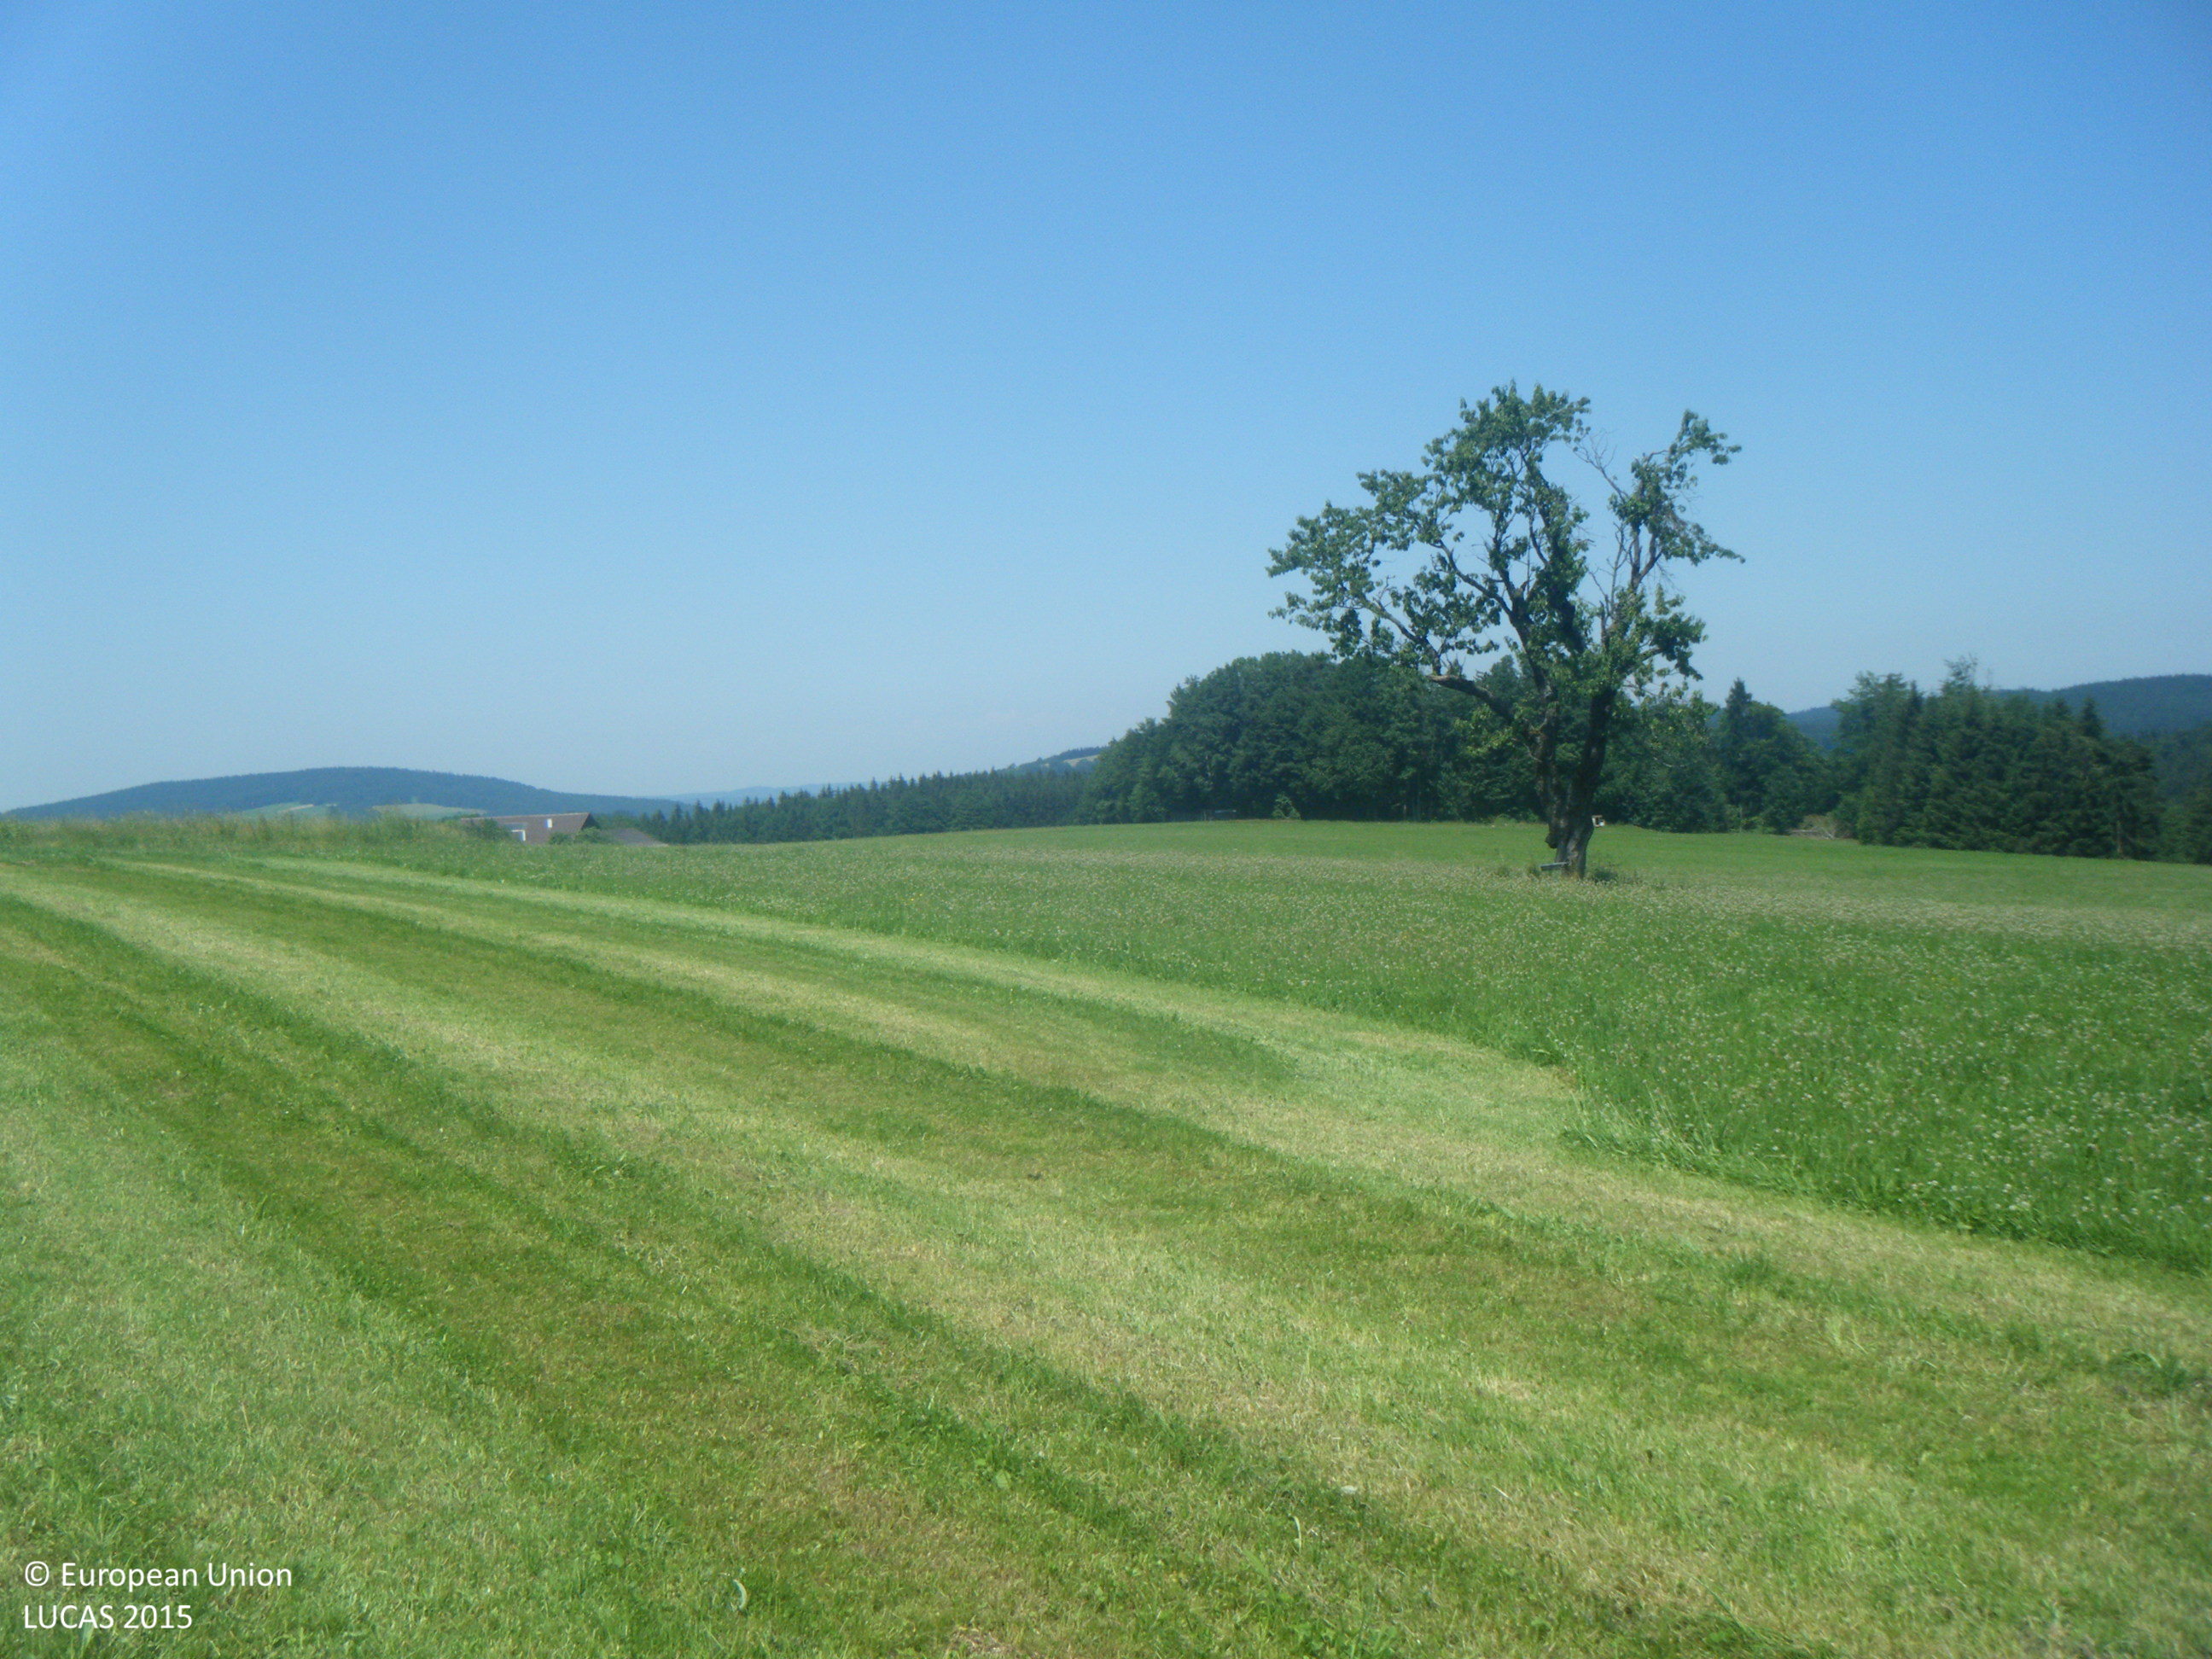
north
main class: Grassland
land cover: Grassland without tree/shrub cover
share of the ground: > 75 %
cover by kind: herbaceous plants 100 %
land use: Agriculture (excluding fallow land and kitchen gardens)
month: July
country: AT
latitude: 47.8843
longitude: 13.3554
